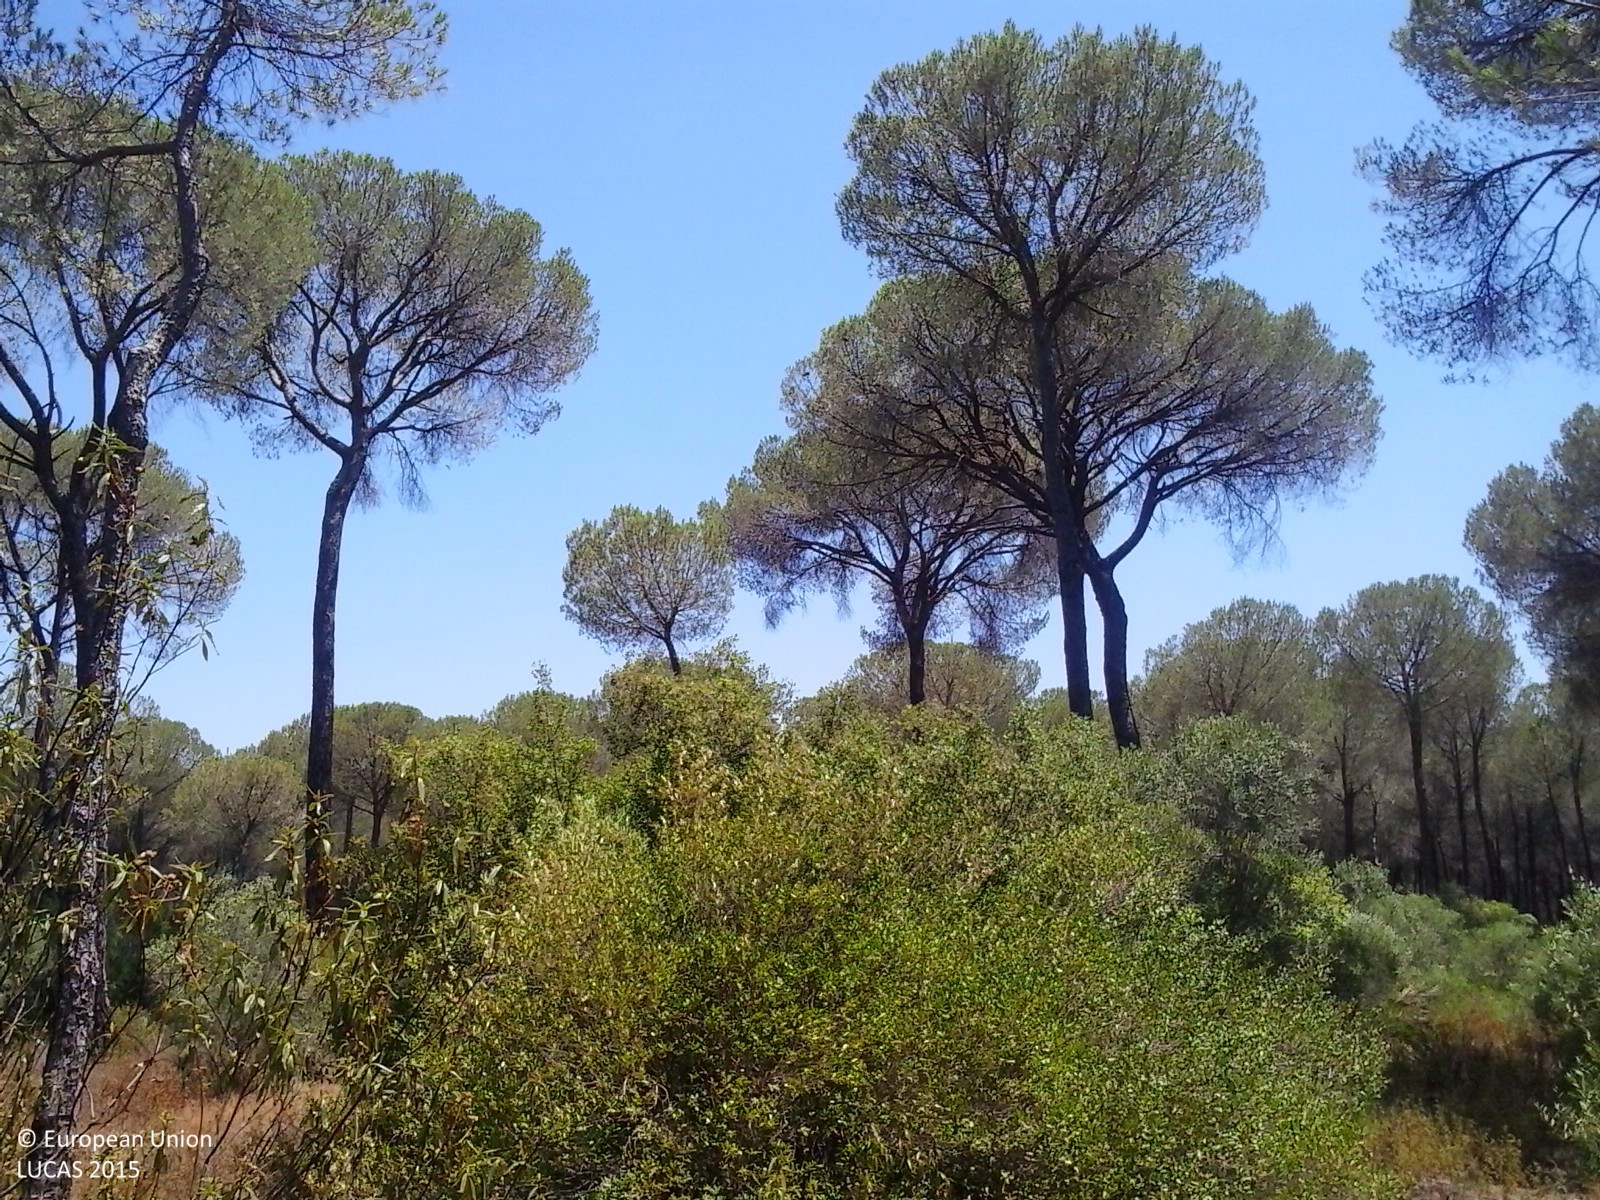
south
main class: Woodland
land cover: Pine dominated coniferous woodland
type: coniferous forest of the mediterranean region
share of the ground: 50 - 75 %
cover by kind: coniferous forest trees 80 %, shrubs 20 %
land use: Forestry
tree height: > 5 m
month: July
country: ES
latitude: 37.2134
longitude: -6.4234
